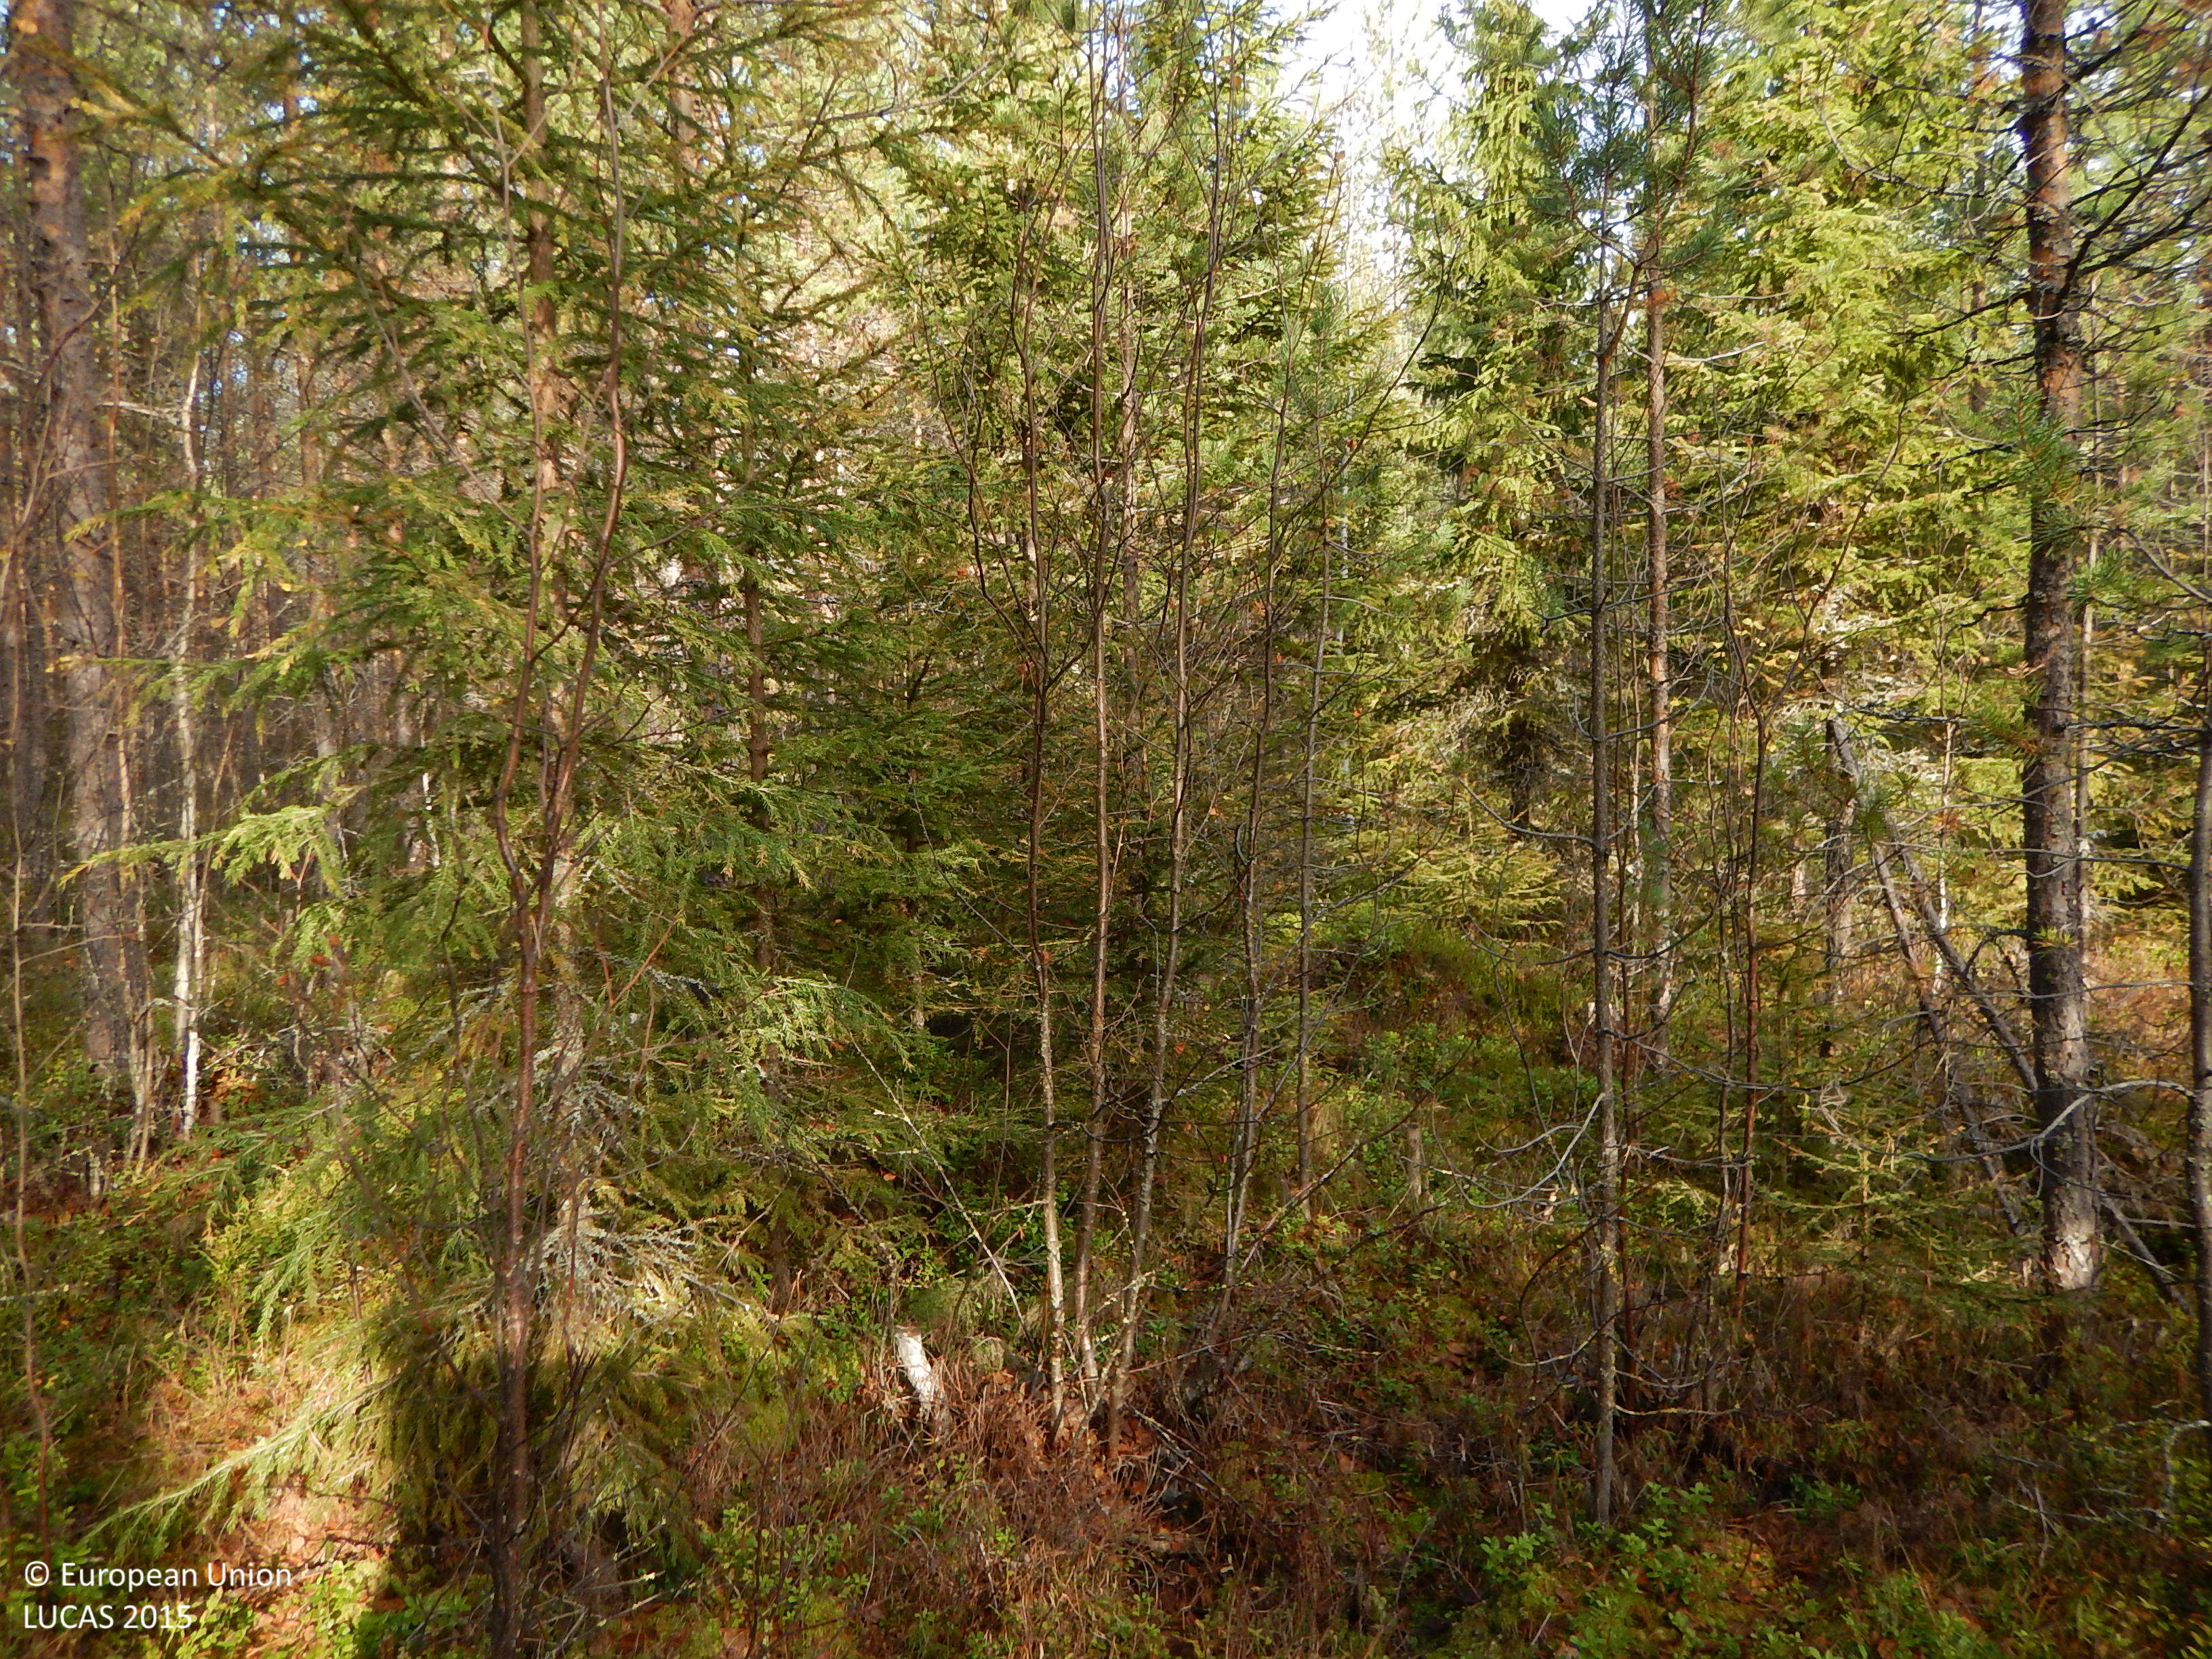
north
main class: Woodland
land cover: Pine dominated coniferous woodland
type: boreal forest
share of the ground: > 75 %
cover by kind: coniferous forest trees 65 %, broadleaved forest trees 10 %, shrubs 10 %, lichens and mosses 10 %, herbaceous plants 5 %
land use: Forestry
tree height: < 5 m
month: October
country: SE
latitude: 64.9203
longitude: 21.1202
